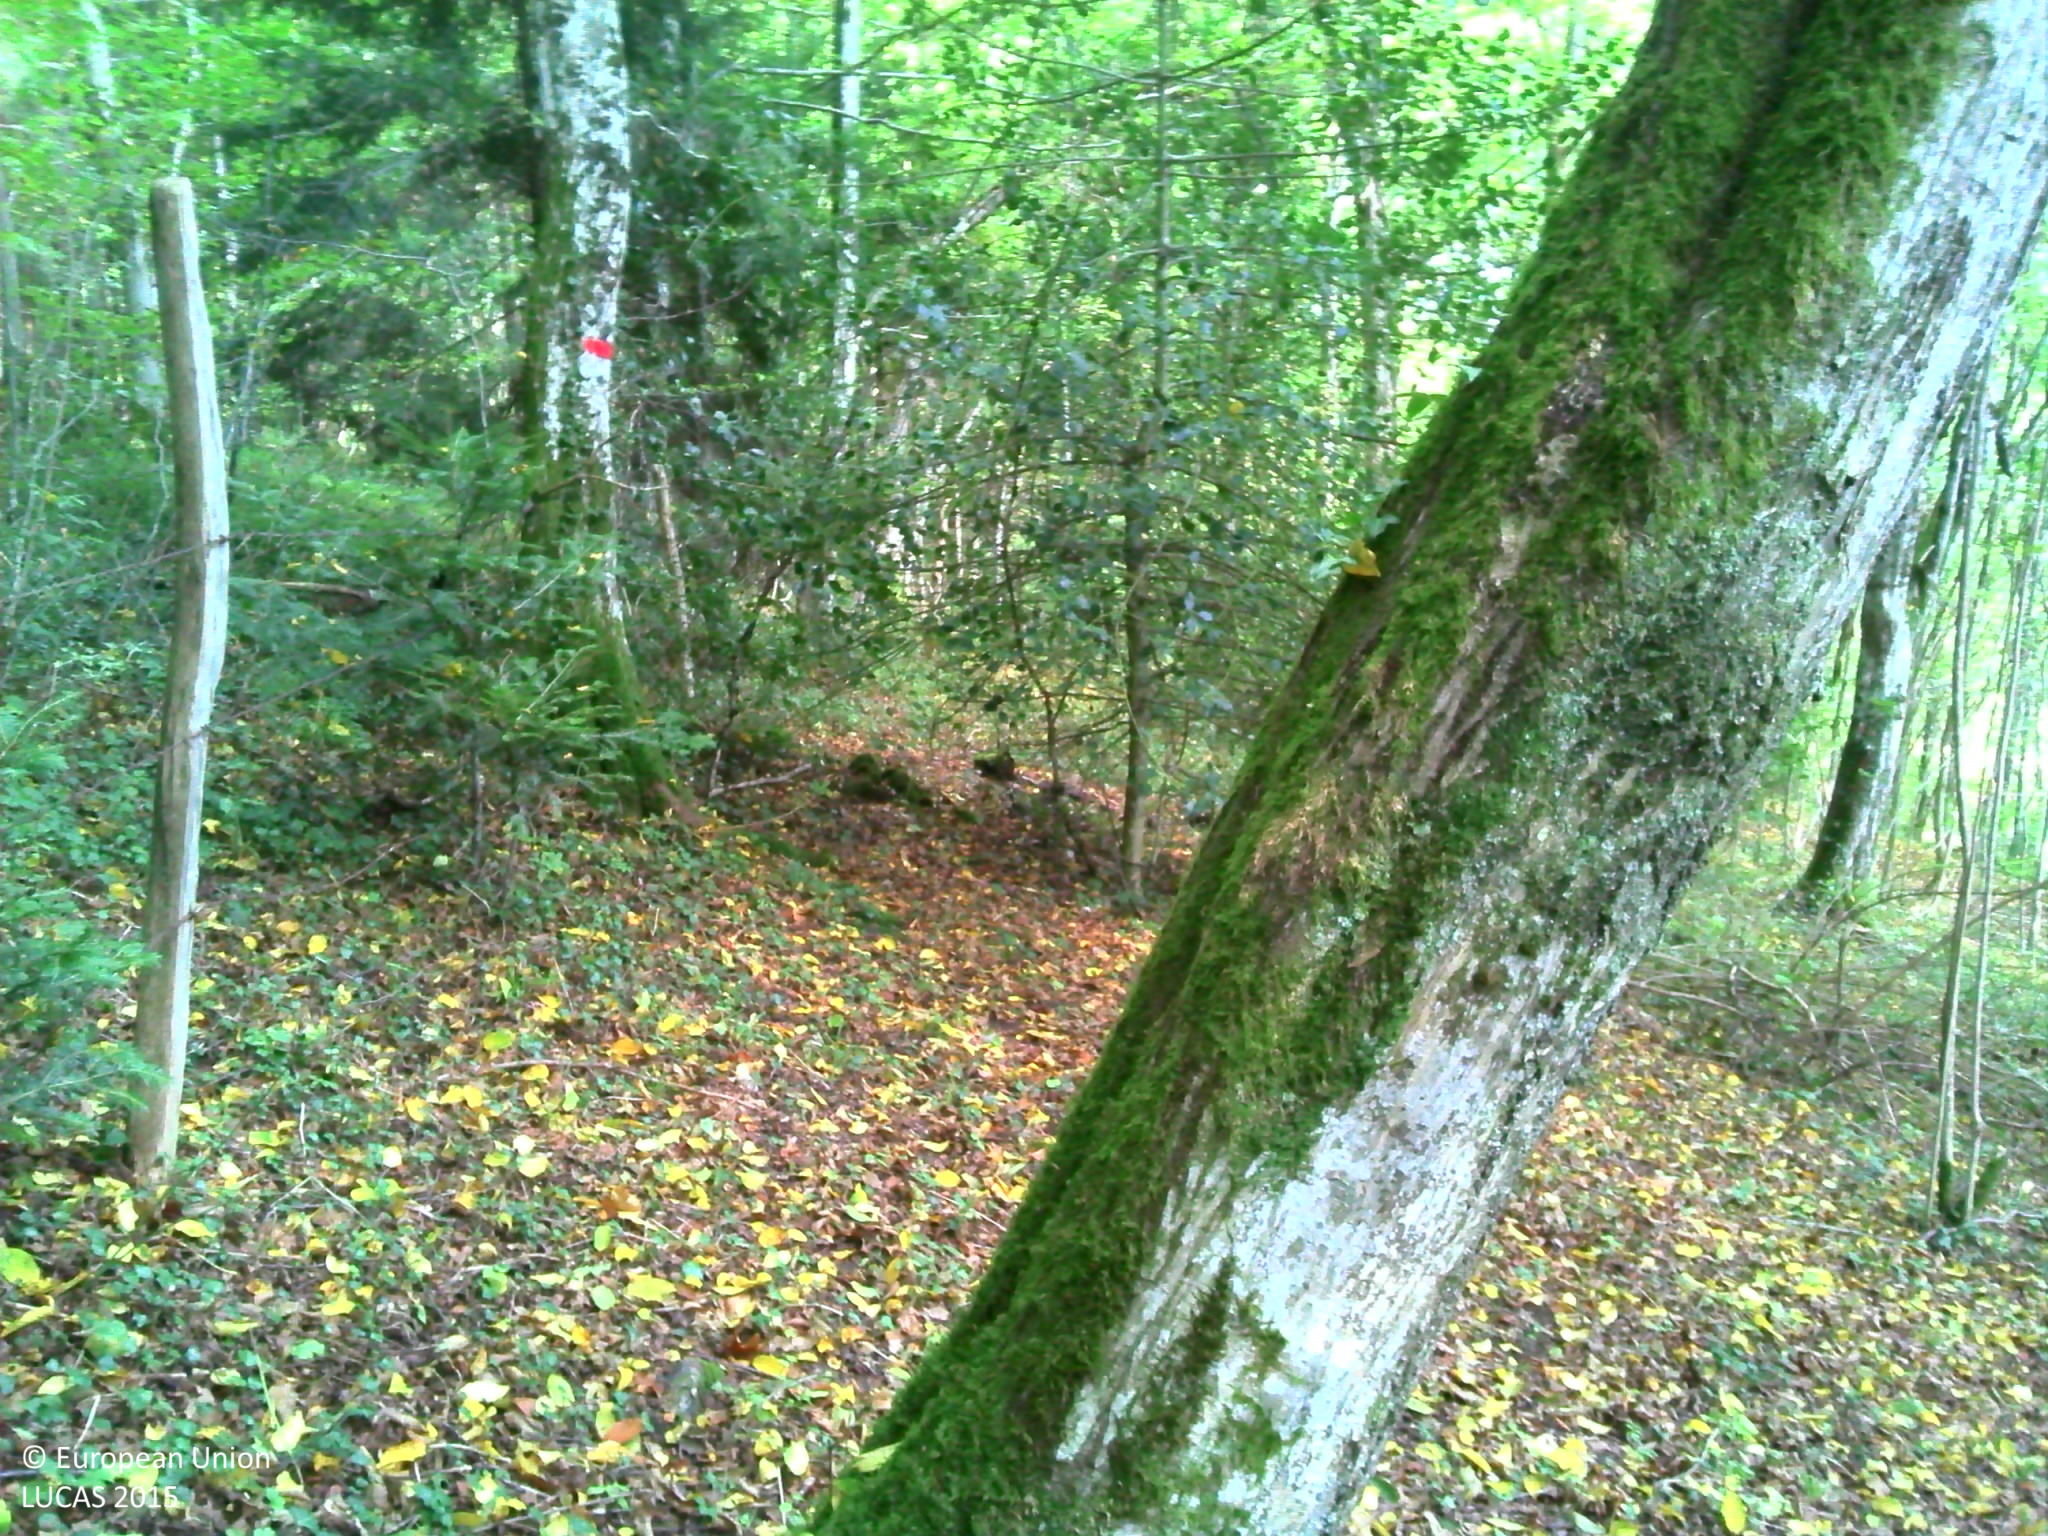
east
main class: Woodland
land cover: Broadleaved woodland
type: beech forest
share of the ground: > 75 %
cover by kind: broadleaved forest trees 75 %, unconsolidated bare surface 15 %, coniferous forest trees 5 %, lichens and mosses 5 %
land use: Forestry
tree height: > 5 m
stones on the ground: < 10 %
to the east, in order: Broadleaved woodland
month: September
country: FR
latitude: 47.3534
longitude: 6.9703
